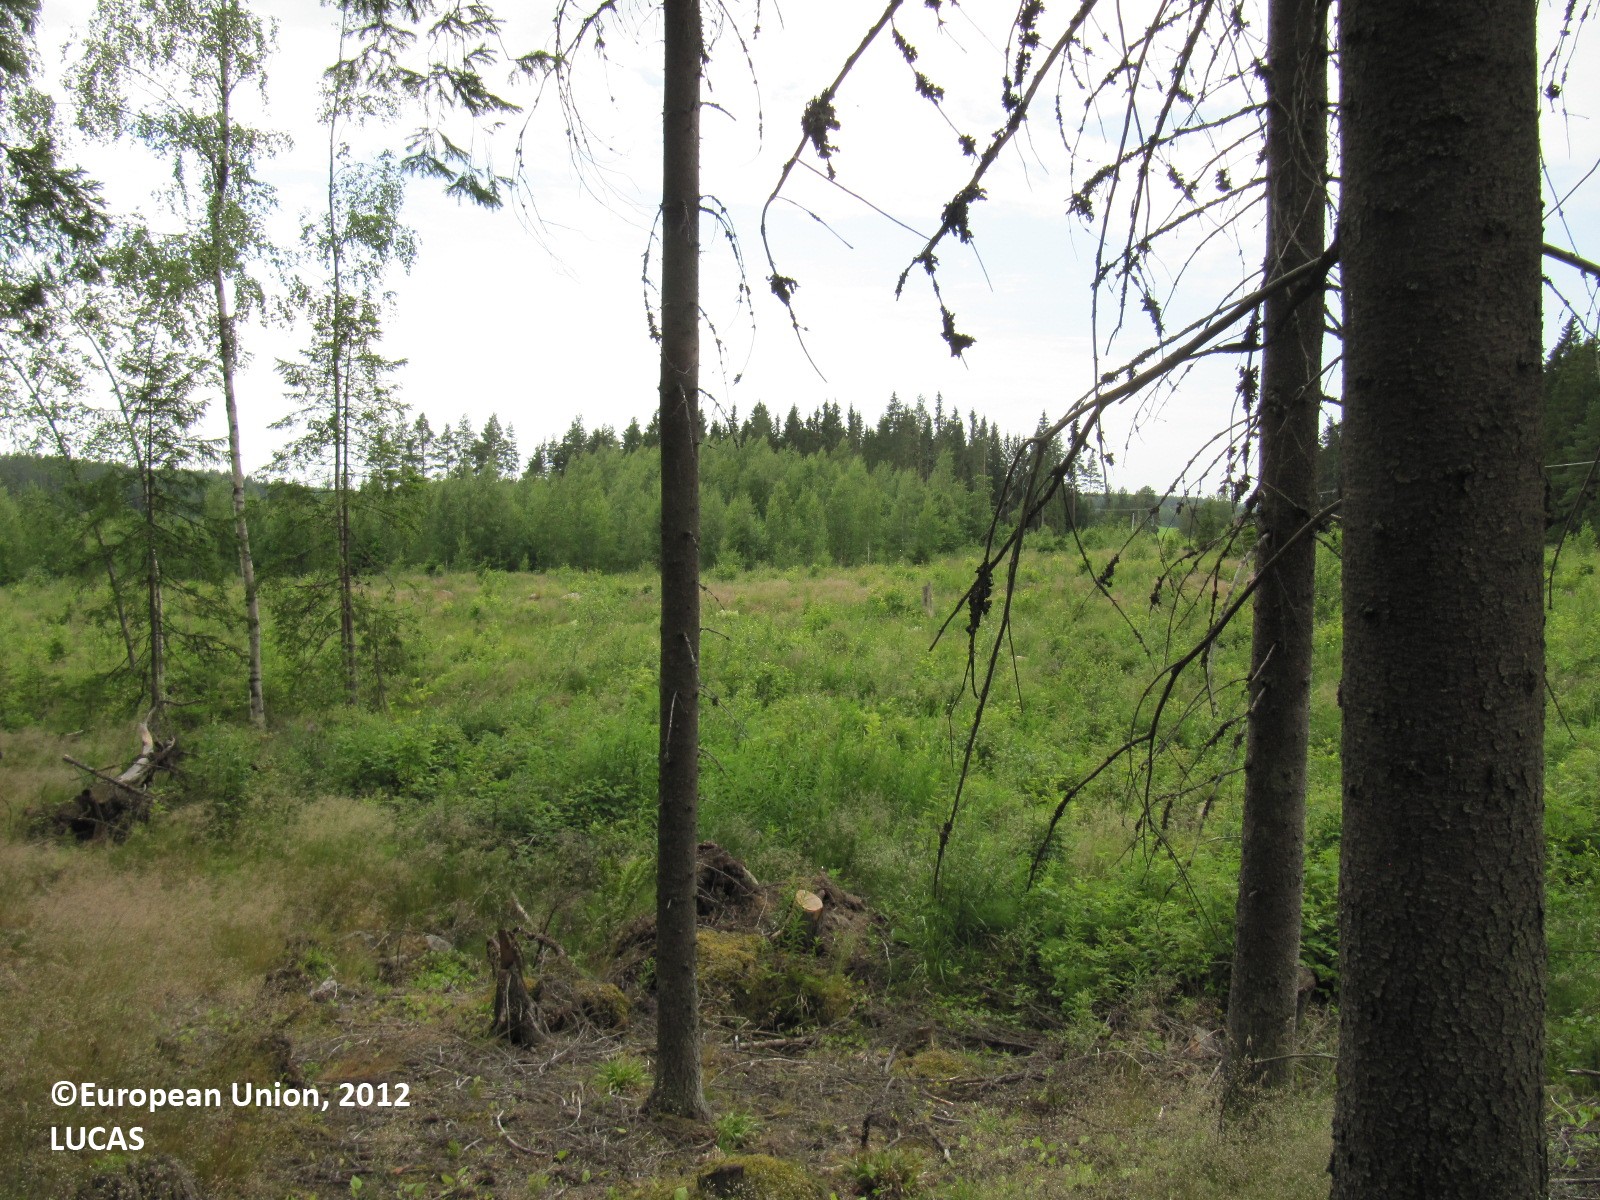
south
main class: Woodland
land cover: Spruce dominated coniferous woodland
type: boreal forest
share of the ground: > 75 %
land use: Forestry
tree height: > 5 m
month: July
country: FI
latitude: 60.9444
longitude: 23.4278
